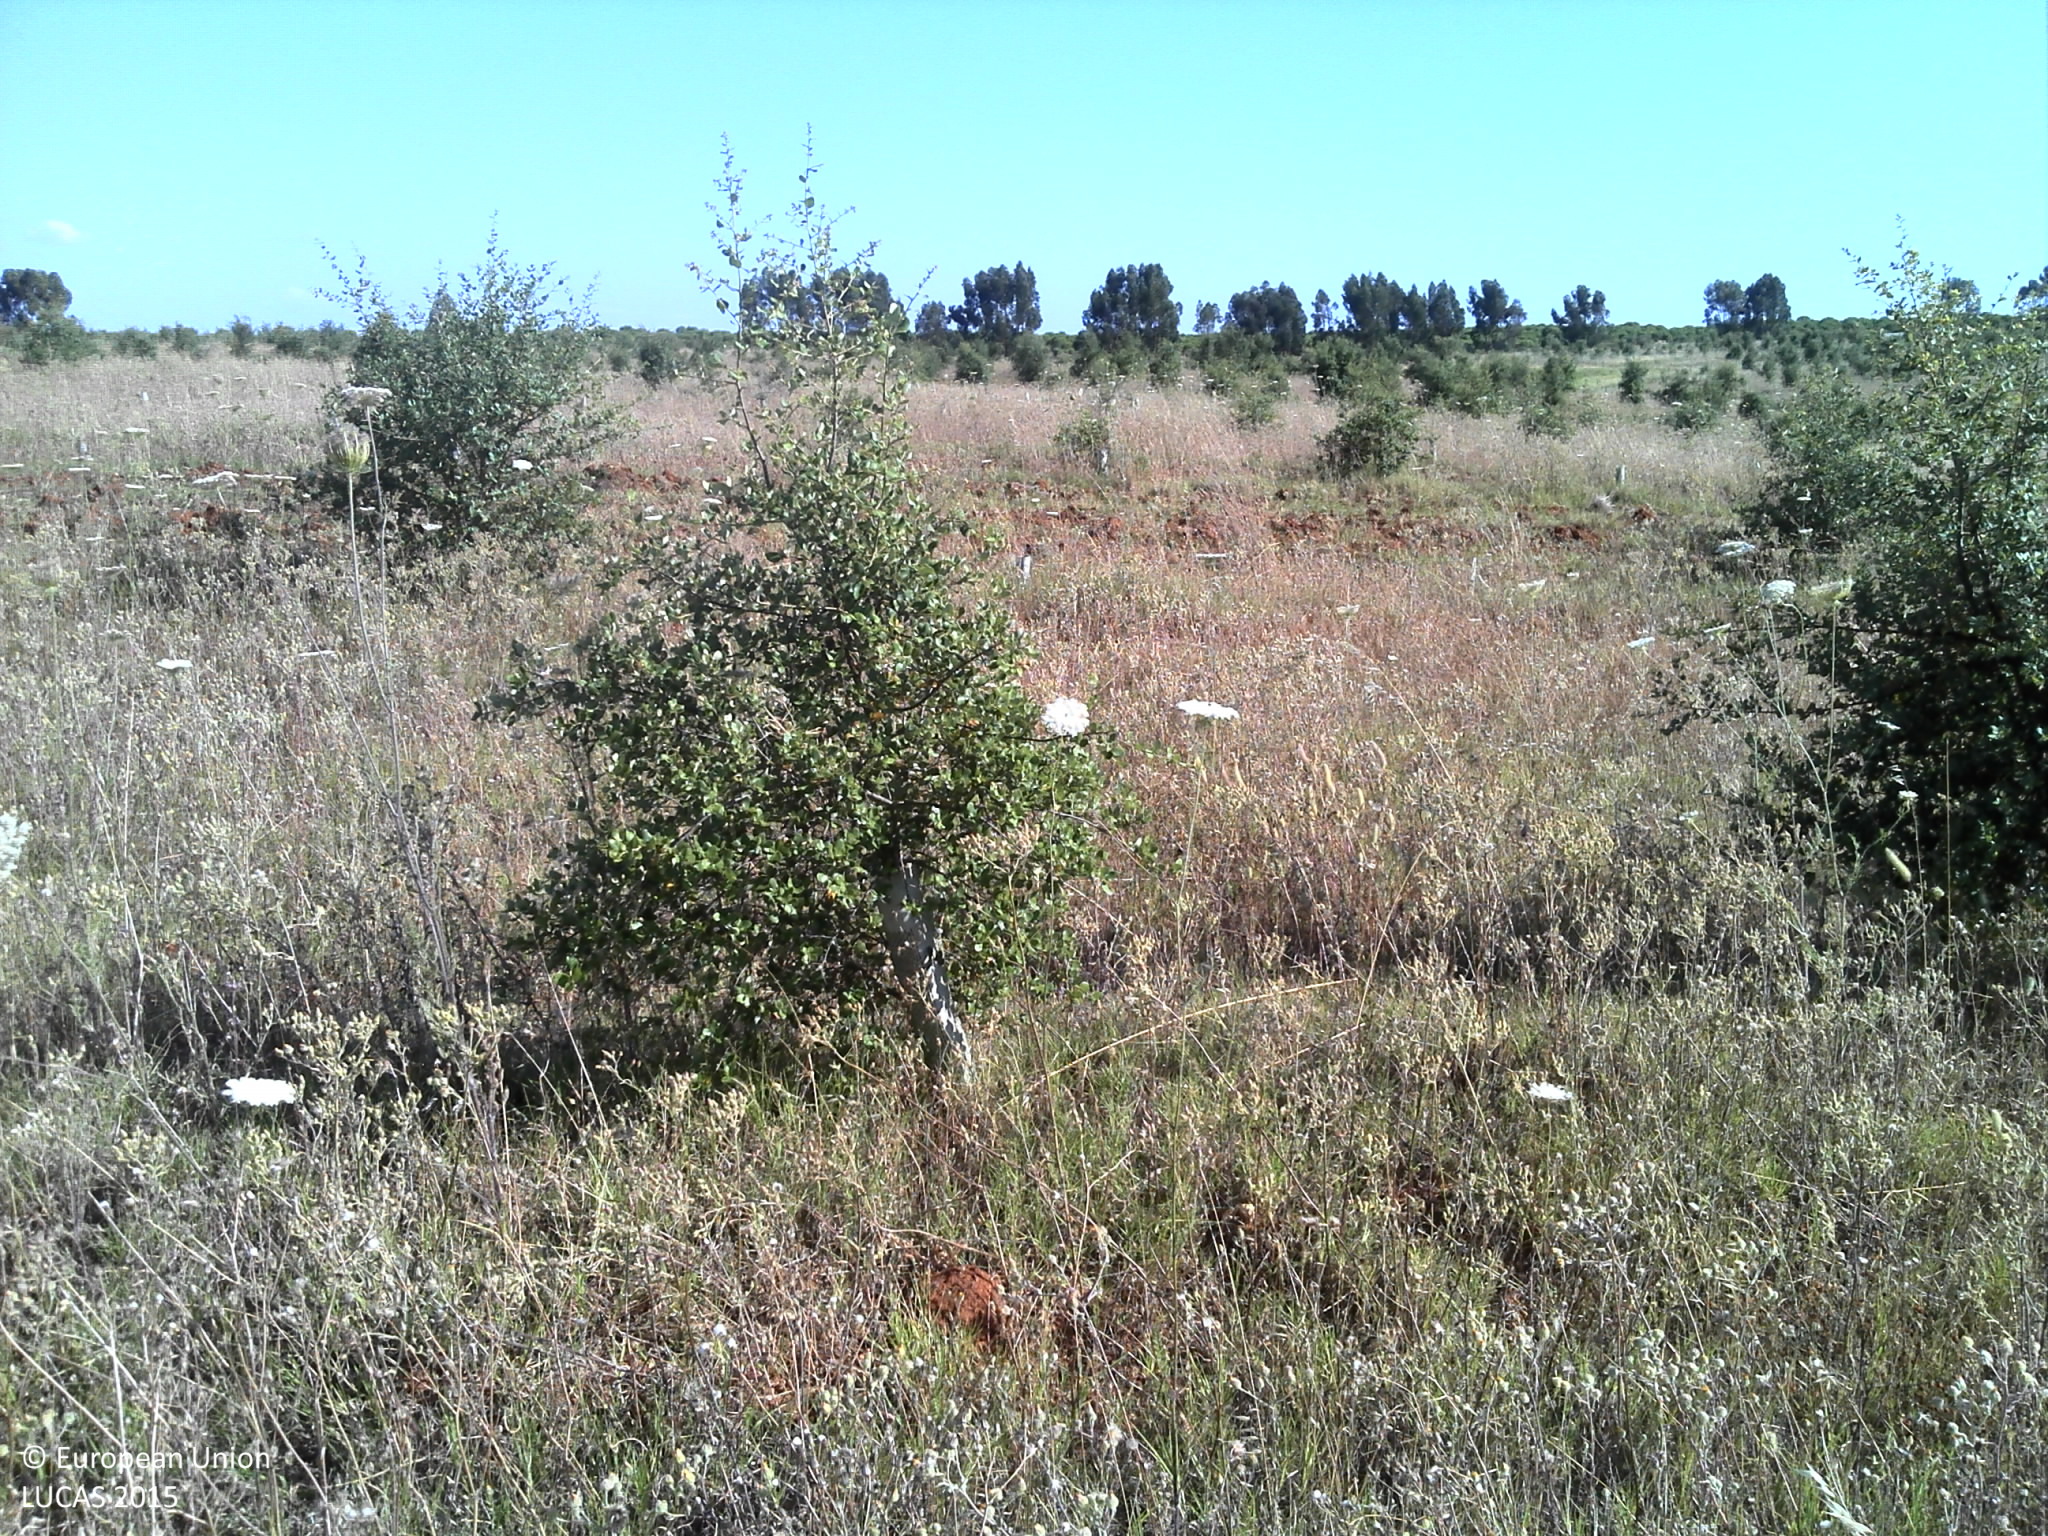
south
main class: Woodland
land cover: Broadleaved woodland
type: broadleaved evergreen forest
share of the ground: 10 - 25 %
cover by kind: herbaceous plants 55 %, unconsolidated bare surface 30 %, broadleaved forest trees 15 %
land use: Forestry
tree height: < 5 m
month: June
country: PT
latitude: 37.9024
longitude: -8.2891
